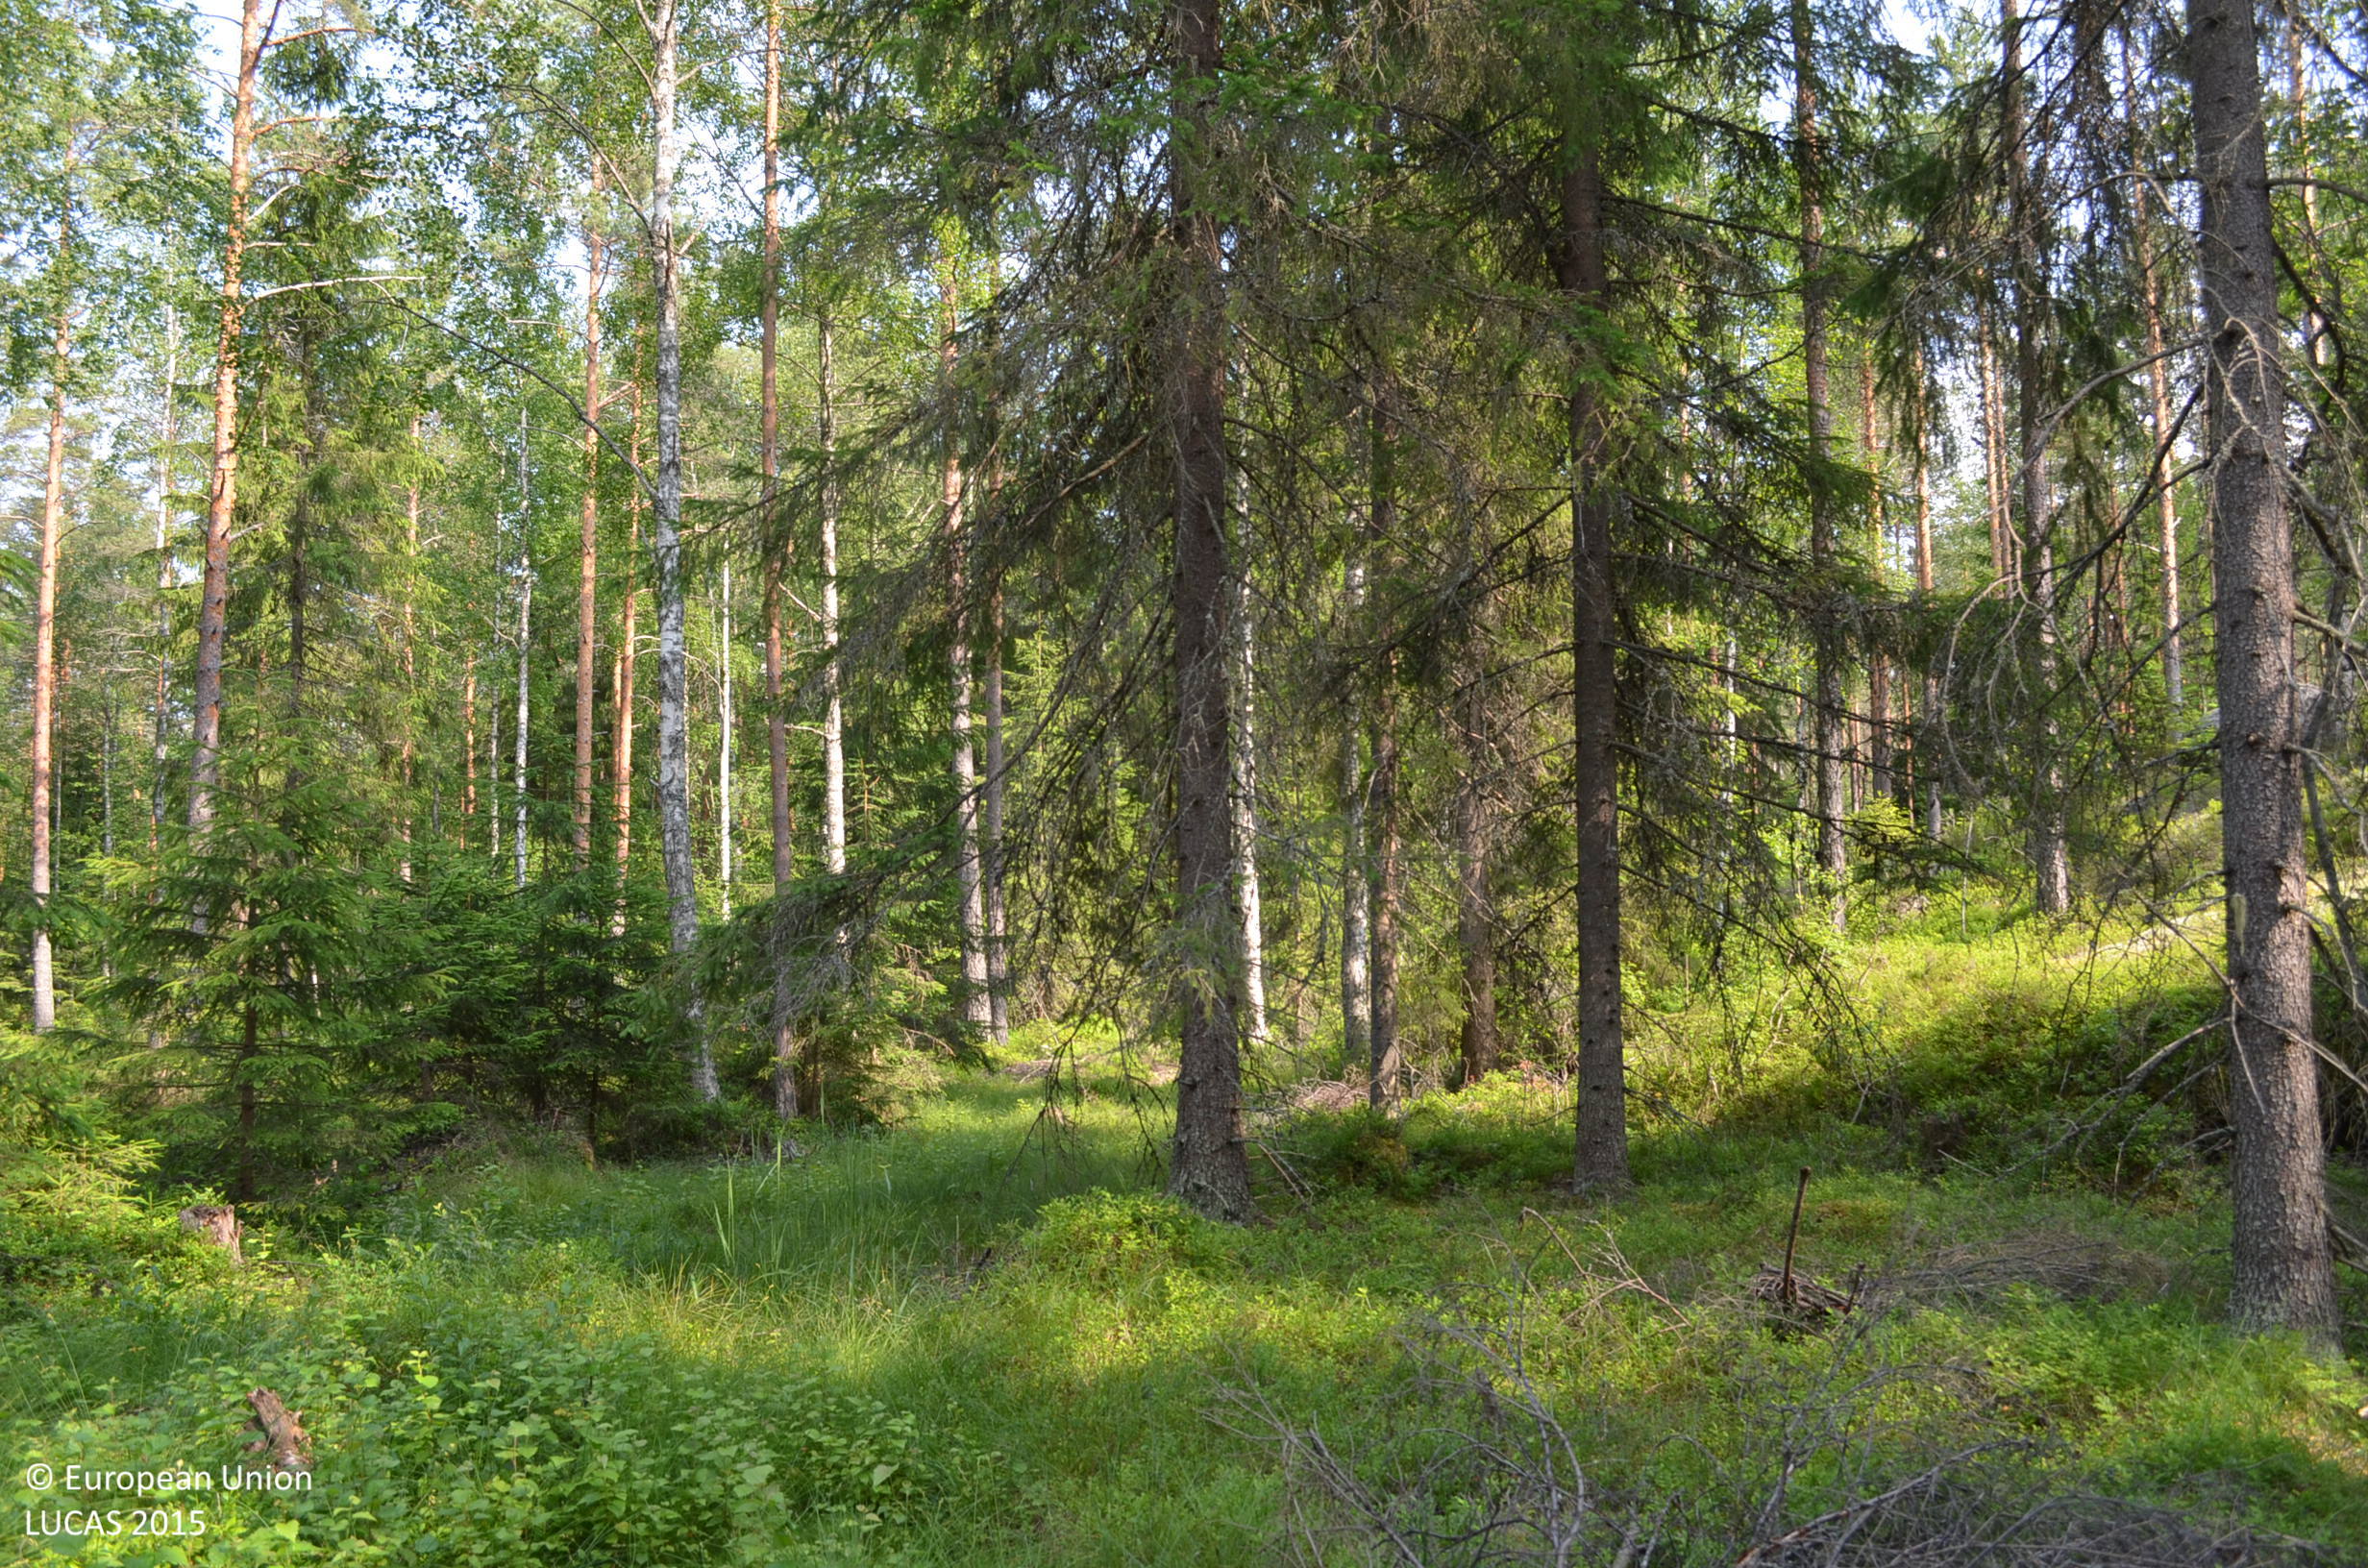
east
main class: Woodland
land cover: Other coniferous woodland
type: boreal forest
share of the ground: 50 - 75 %
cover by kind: coniferous forest trees 60 %, shrubs 30 %, broadleaved forest trees 5 %, herbaceous plants 5 %
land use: Forestry
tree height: > 5 m
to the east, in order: Other coniferous woodland; Pine dominated mixed woodland; Ditches and canals; Pine dominated mixed woodland; Ditches and canals; Pine dominated mixed woodland; Ditches and canals; Pine dominated mixed woodland; Pine dominated coniferous woodland; Abandoned hedges; Ditches and canals; Grass margins; Tracks; Grass margins; Ditches and canals; Pine dominated mixed woodland
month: July
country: FI
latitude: 62.2193
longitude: 23.5170
